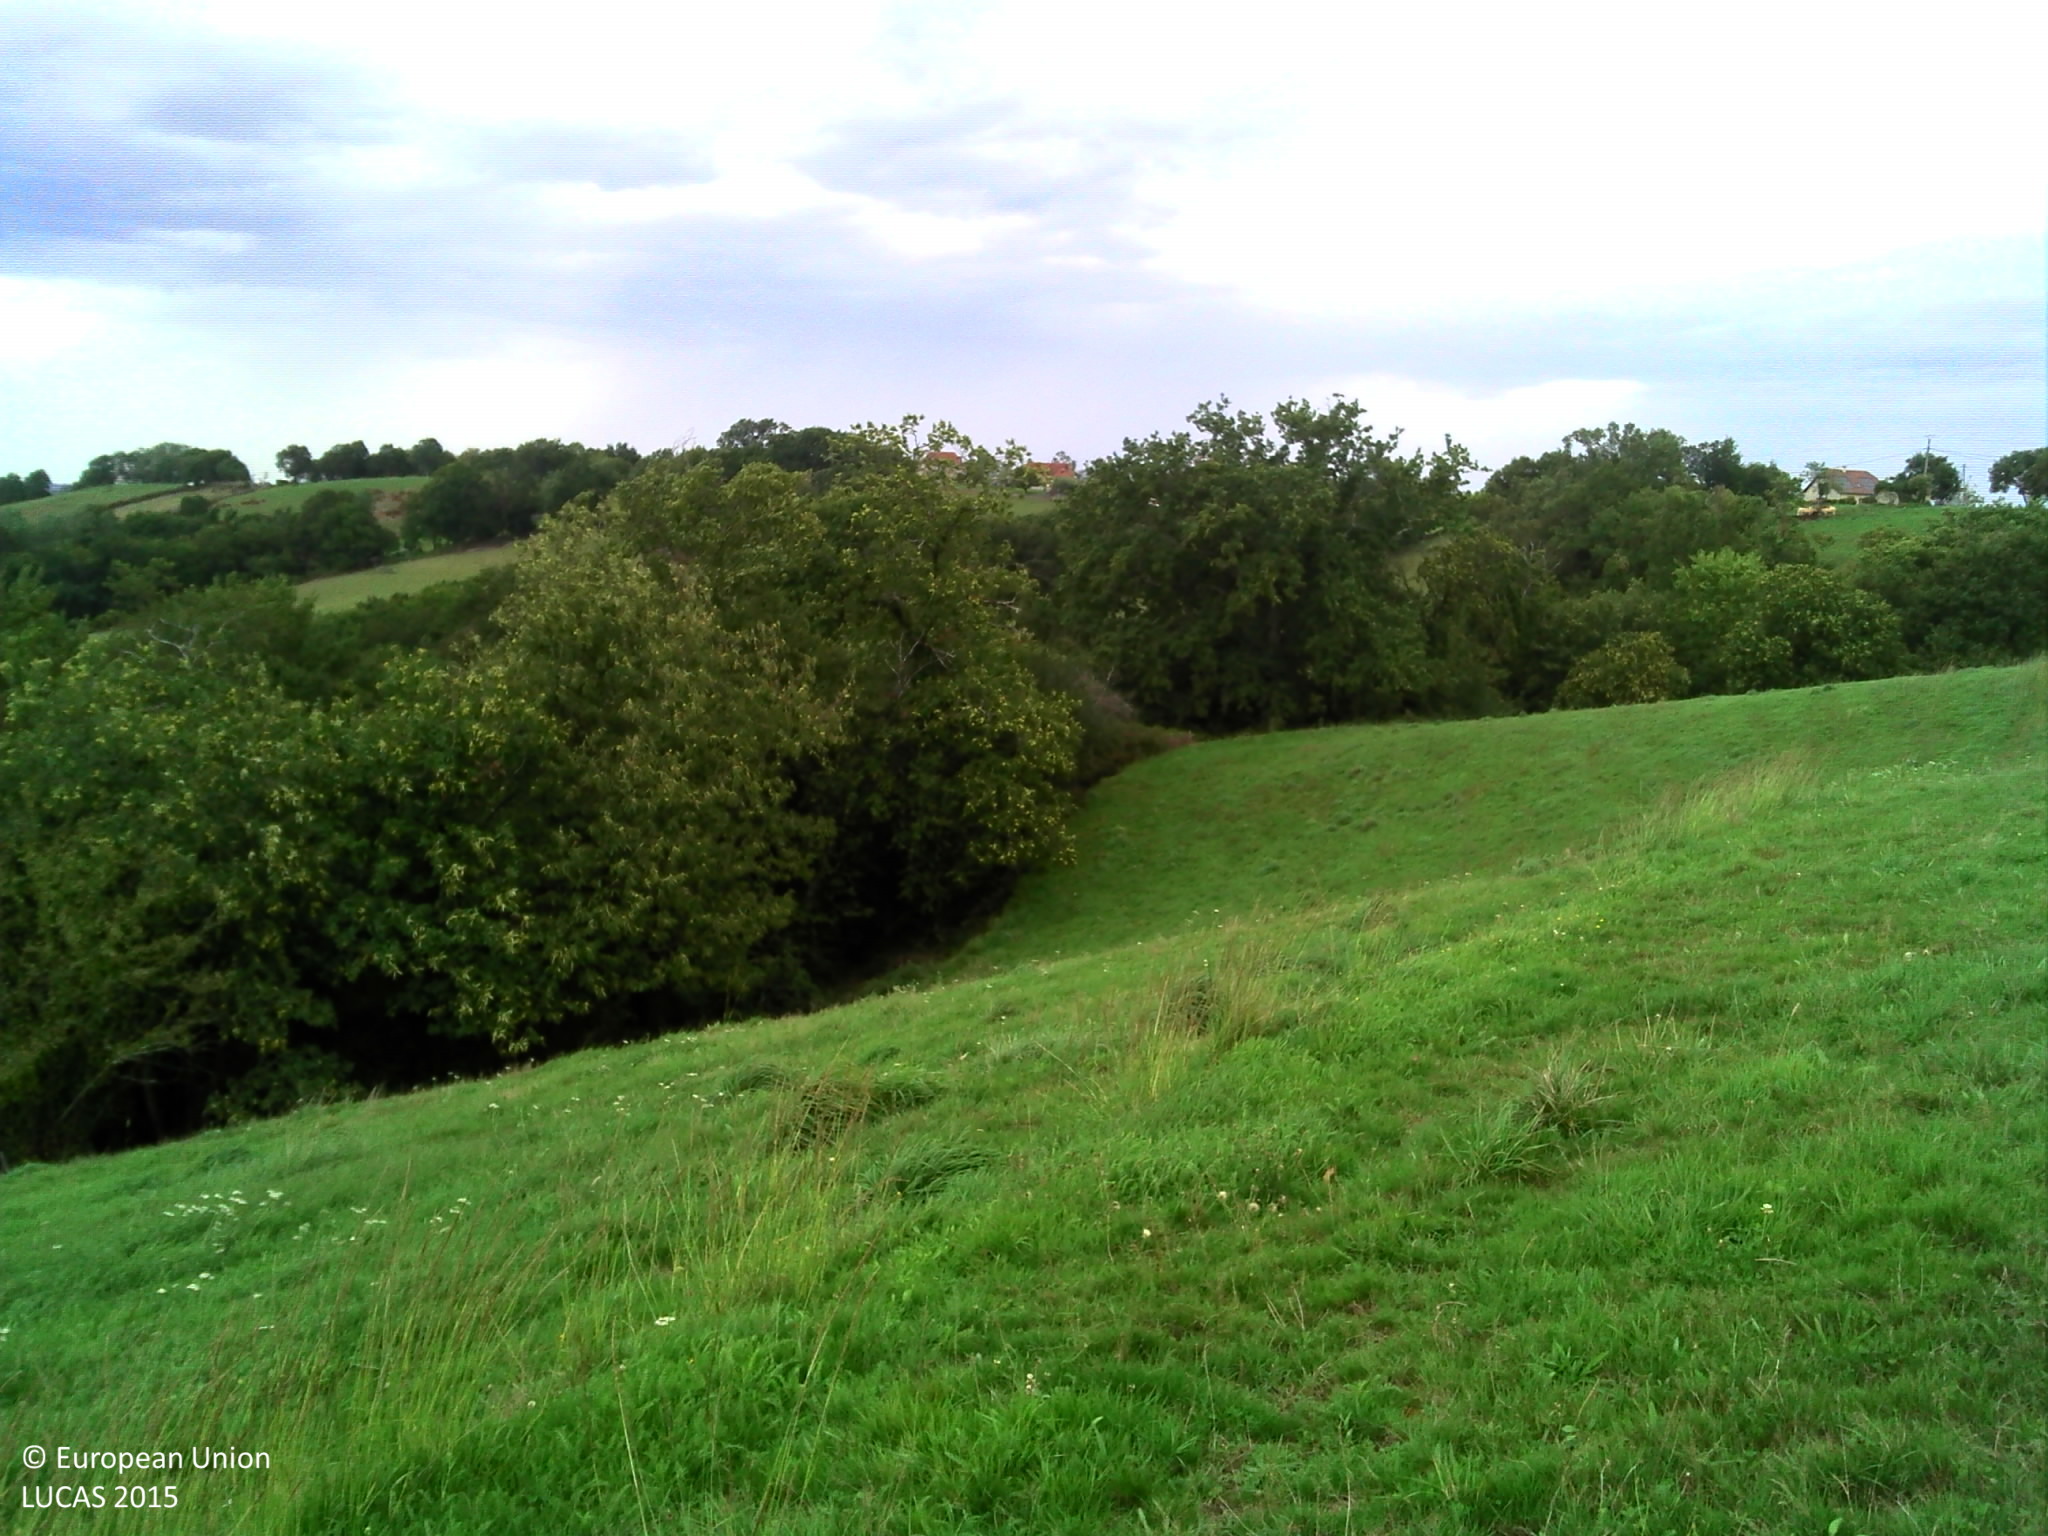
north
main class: Grassland
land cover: Grassland without tree/shrub cover
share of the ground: > 75 %
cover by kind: herbaceous plants 100 %
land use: Agriculture (excluding fallow land and kitchen gardens)
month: September
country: FR
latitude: 43.3789
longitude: -0.6865
